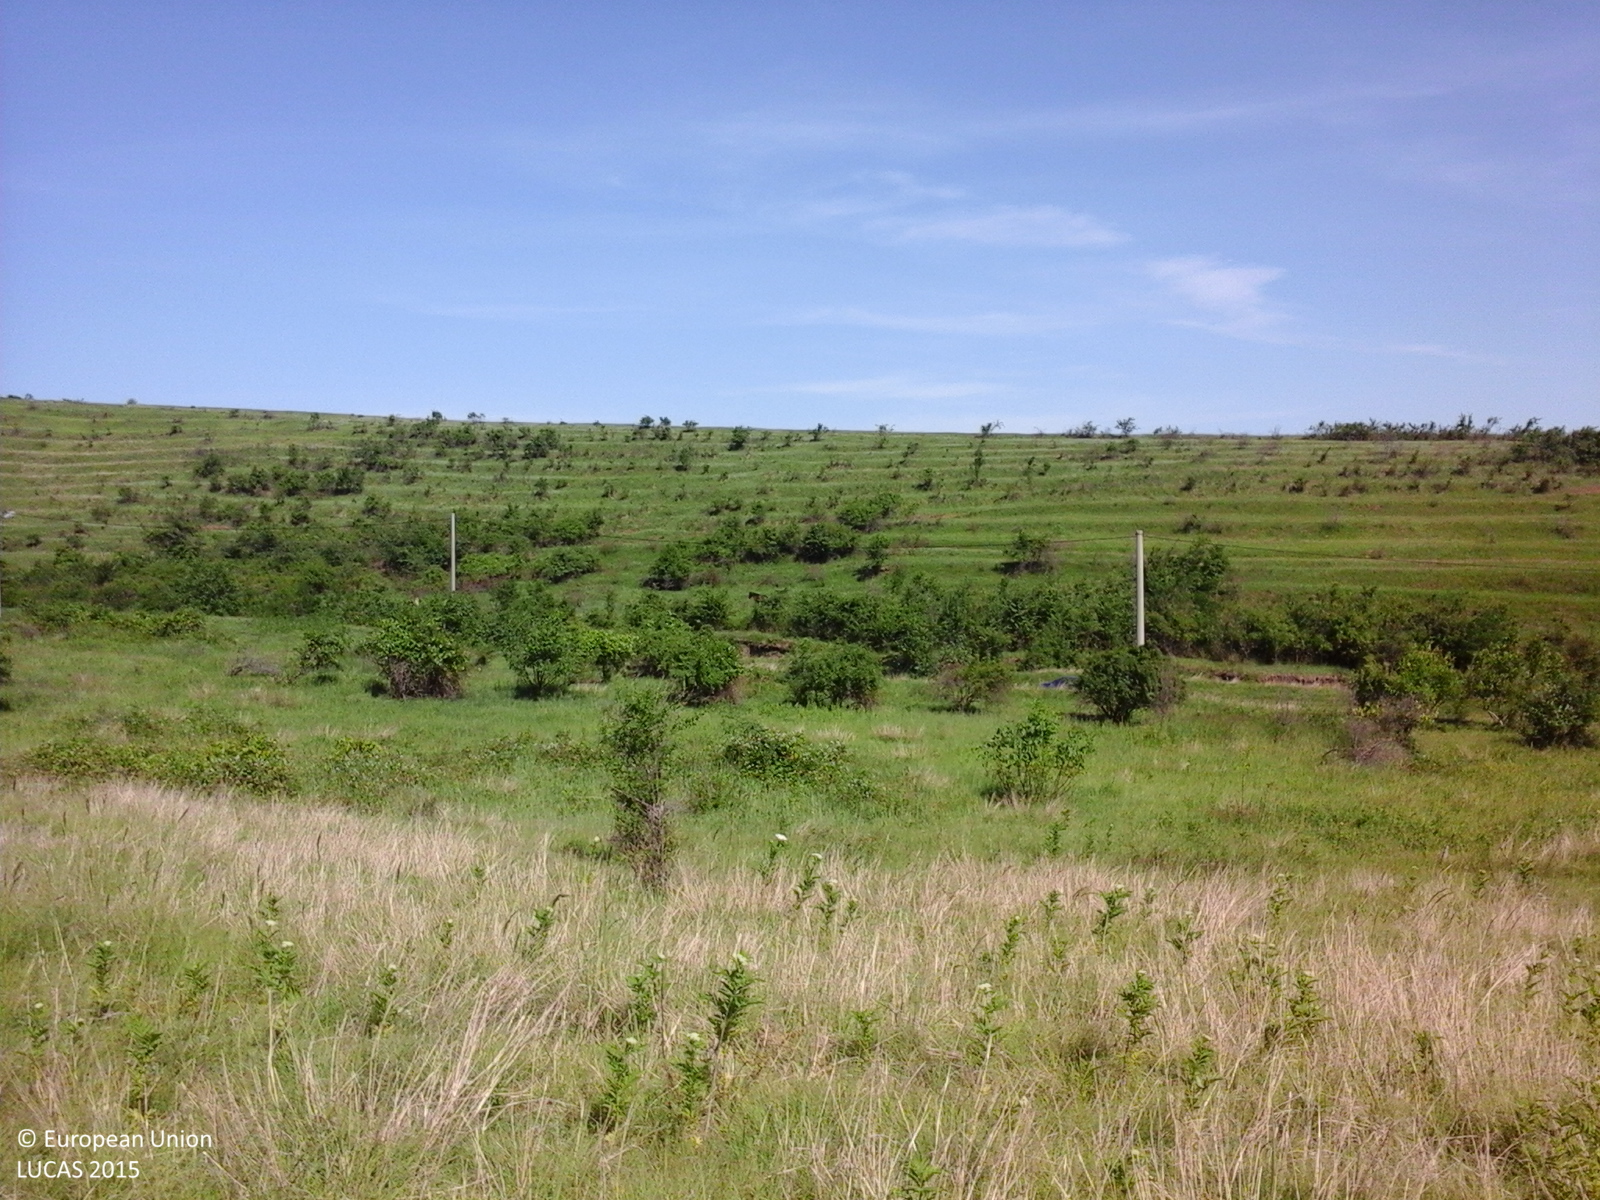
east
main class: Grassland
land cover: Grassland with sparse tree/shrub cover
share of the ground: > 75 %
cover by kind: herbaceous plants 90 %, coniferous forest trees 5 %, shrubs 5 %
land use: Agriculture (excluding fallow land and kitchen gardens)
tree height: < 5 m
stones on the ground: < 10 %
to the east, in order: Grassland with sparse tree/shrub cover; Electric lines; Grassland with sparse tree/shrub cover; Tracks; Grass margins; Spontaneously vegetated surfaces; Broadleaved woodland; Grassland with sparse tree/shrub cover; Tracks; Grassland with sparse tree/shrub cover; Vineyards
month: June
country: RO
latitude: 45.0038
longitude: 26.2650
